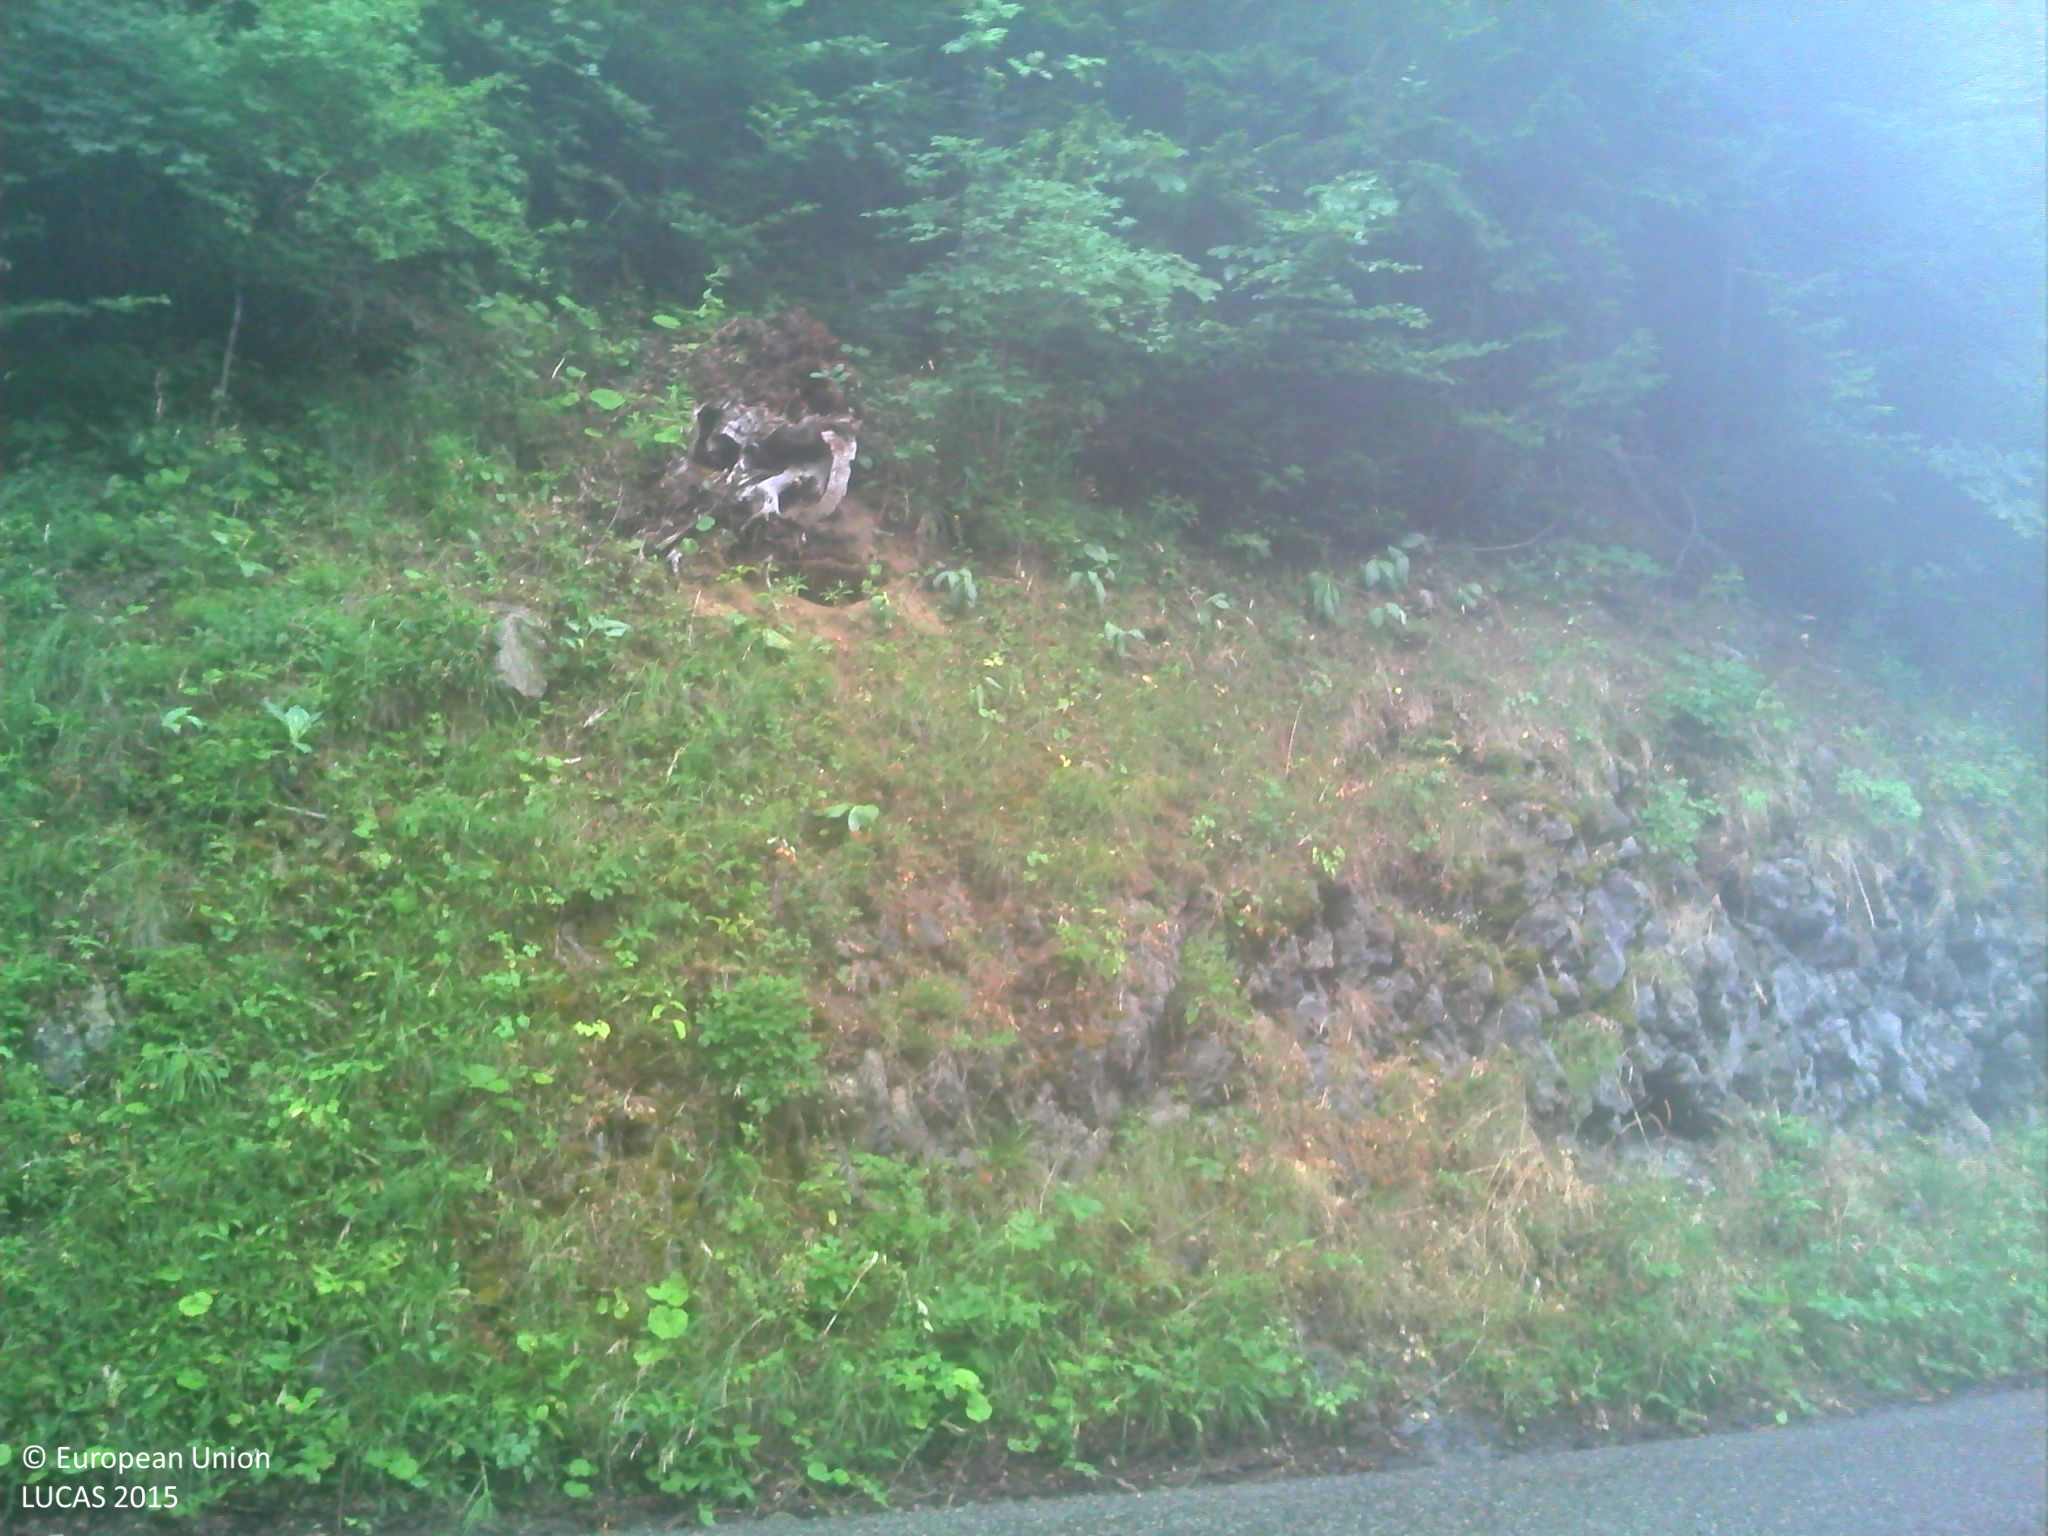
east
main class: Woodland
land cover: Spruce dominated coniferous woodland
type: alpine coniferous forest
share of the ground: > 75 %
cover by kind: coniferous forest trees 70 %, broadleaved forest trees 15 %, herbaceous plants 10 %, lichens and mosses 5 %
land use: Semi-natural and natural areas not in use
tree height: > 5 m
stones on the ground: 25 - 50 %
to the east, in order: Spruce dominated coniferous woodland; Grass margins; Fences; Paved roads, cycling and walking lanes; Spruce dominated coniferous woodland; Grass margins; Fences; Paved roads, cycling and walking lanes; Spruce dominated coniferous woodland
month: July
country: FR
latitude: 45.9627
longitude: 6.3005
